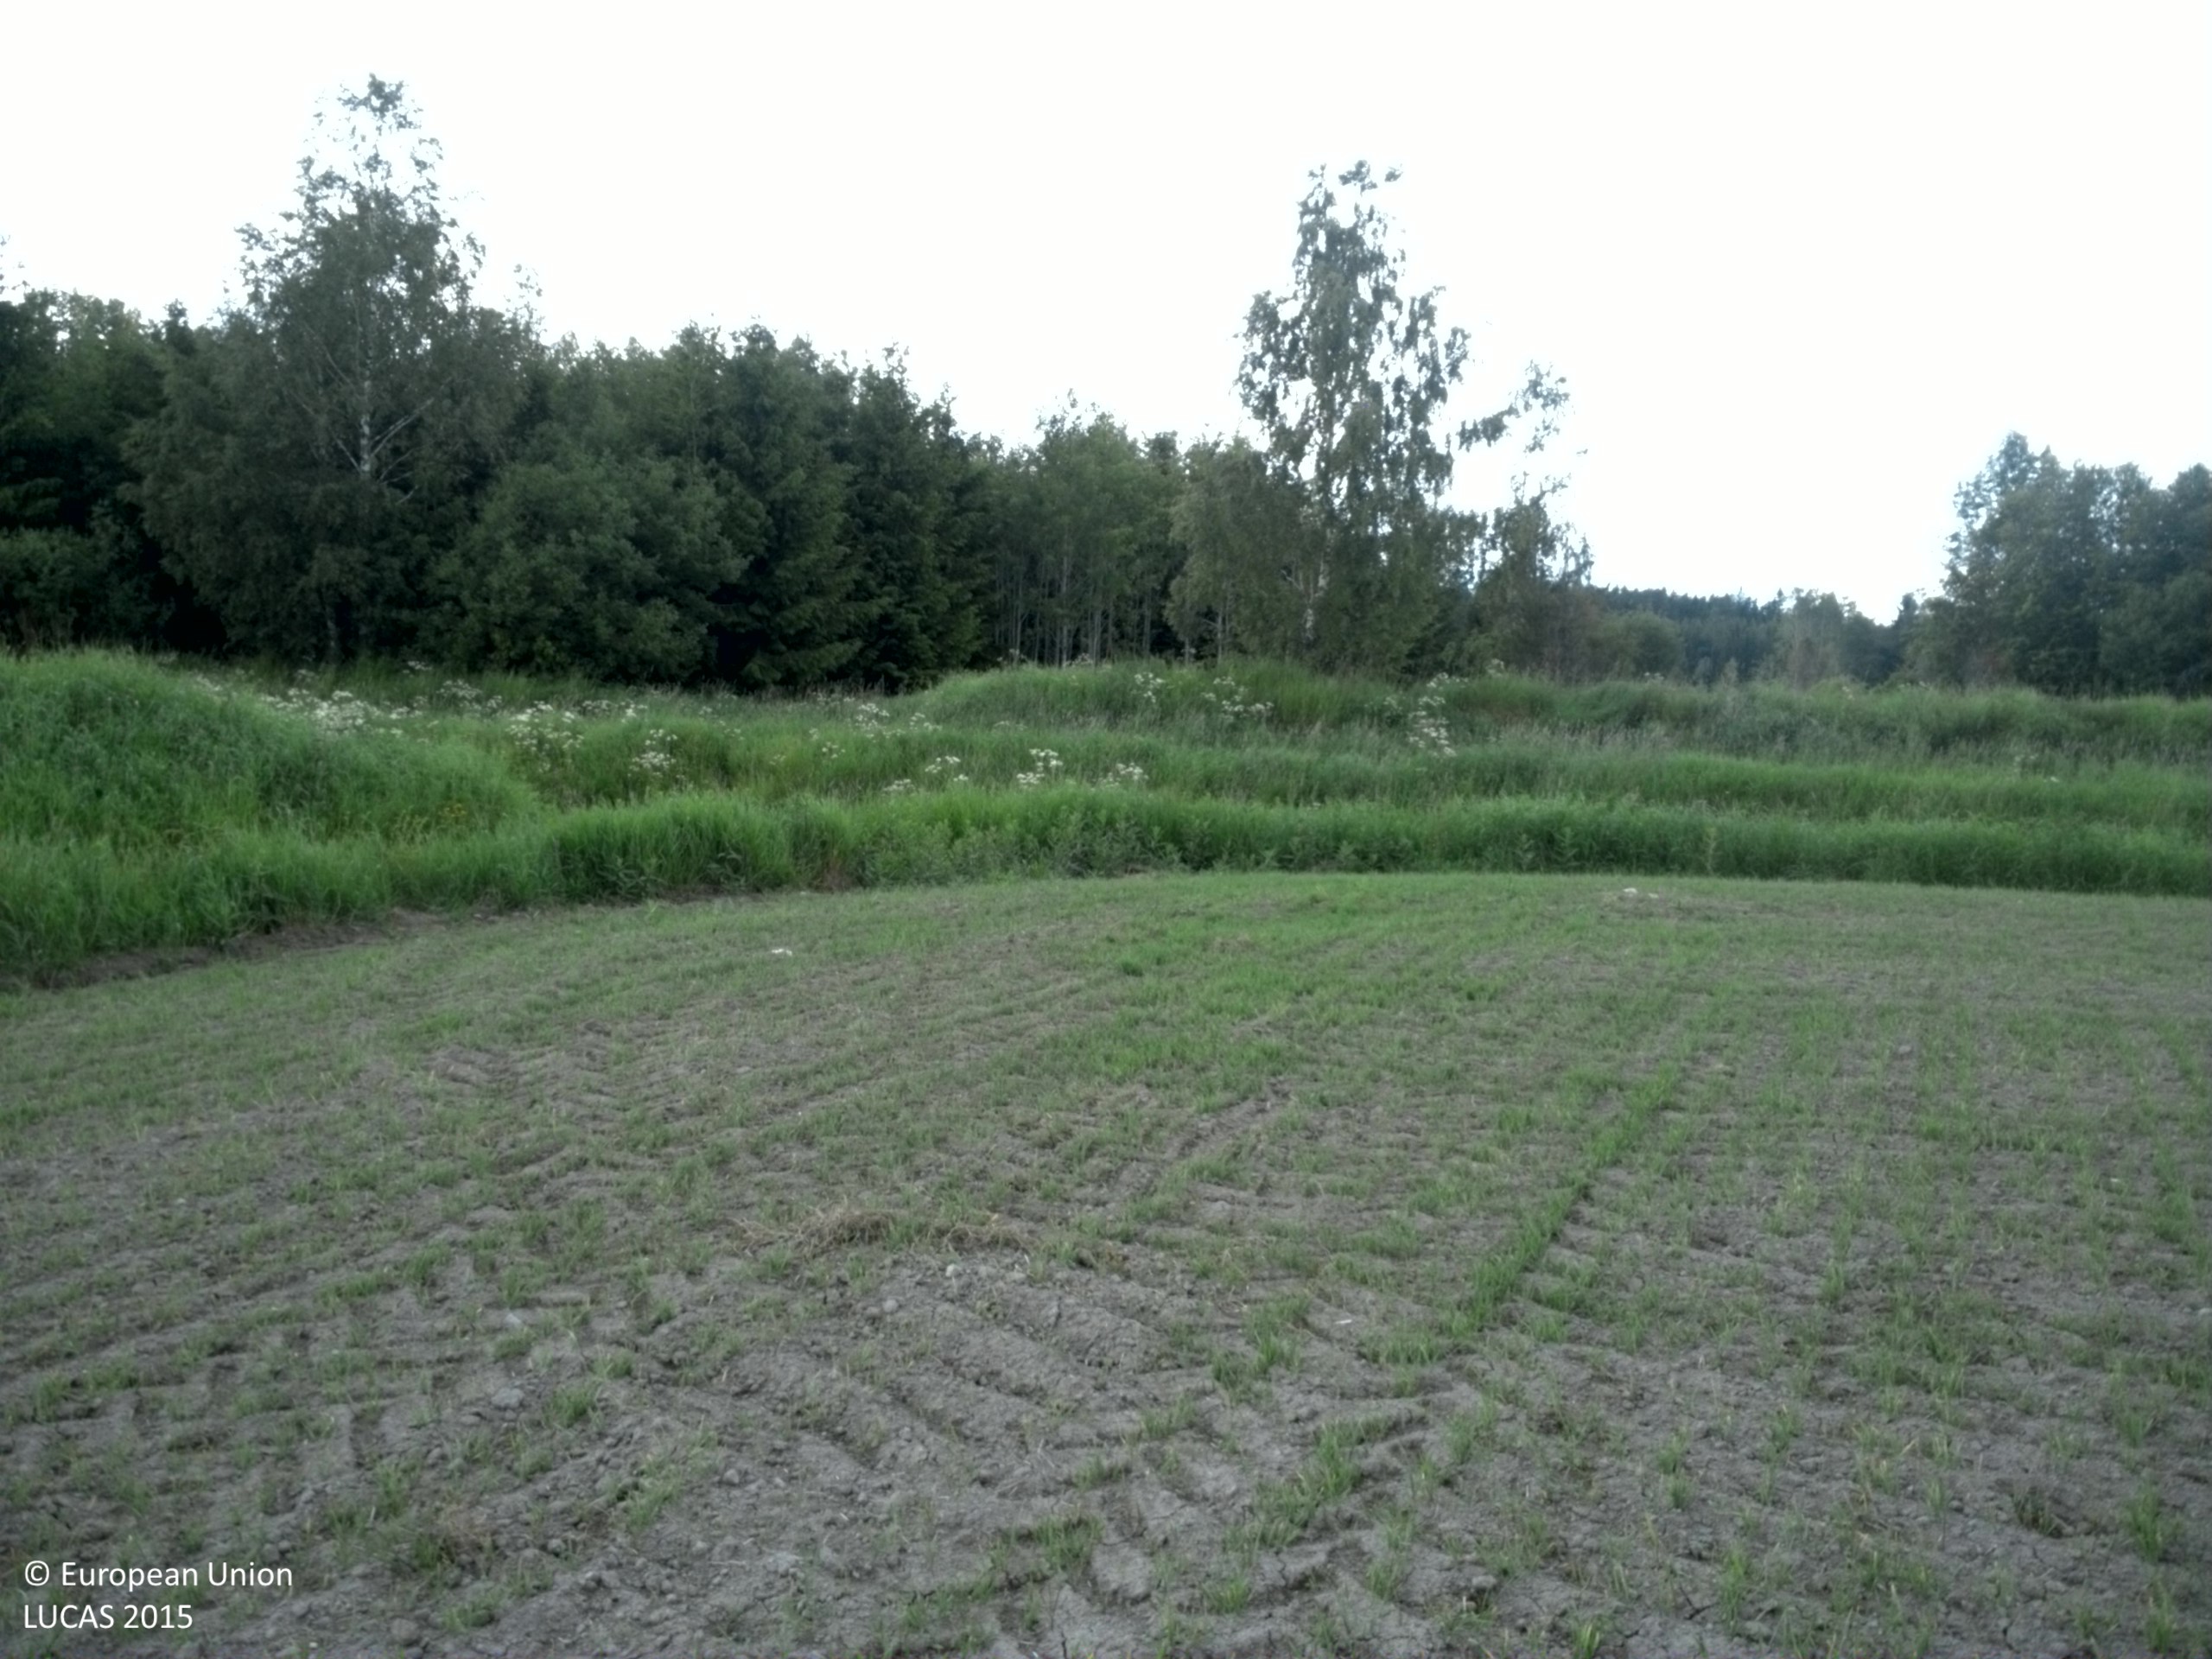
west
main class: Cropland
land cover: Barley
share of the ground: 25 - 50 %
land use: Agriculture (excluding fallow land and kitchen gardens)
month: June
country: SE
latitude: 60.2950
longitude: 17.7177
